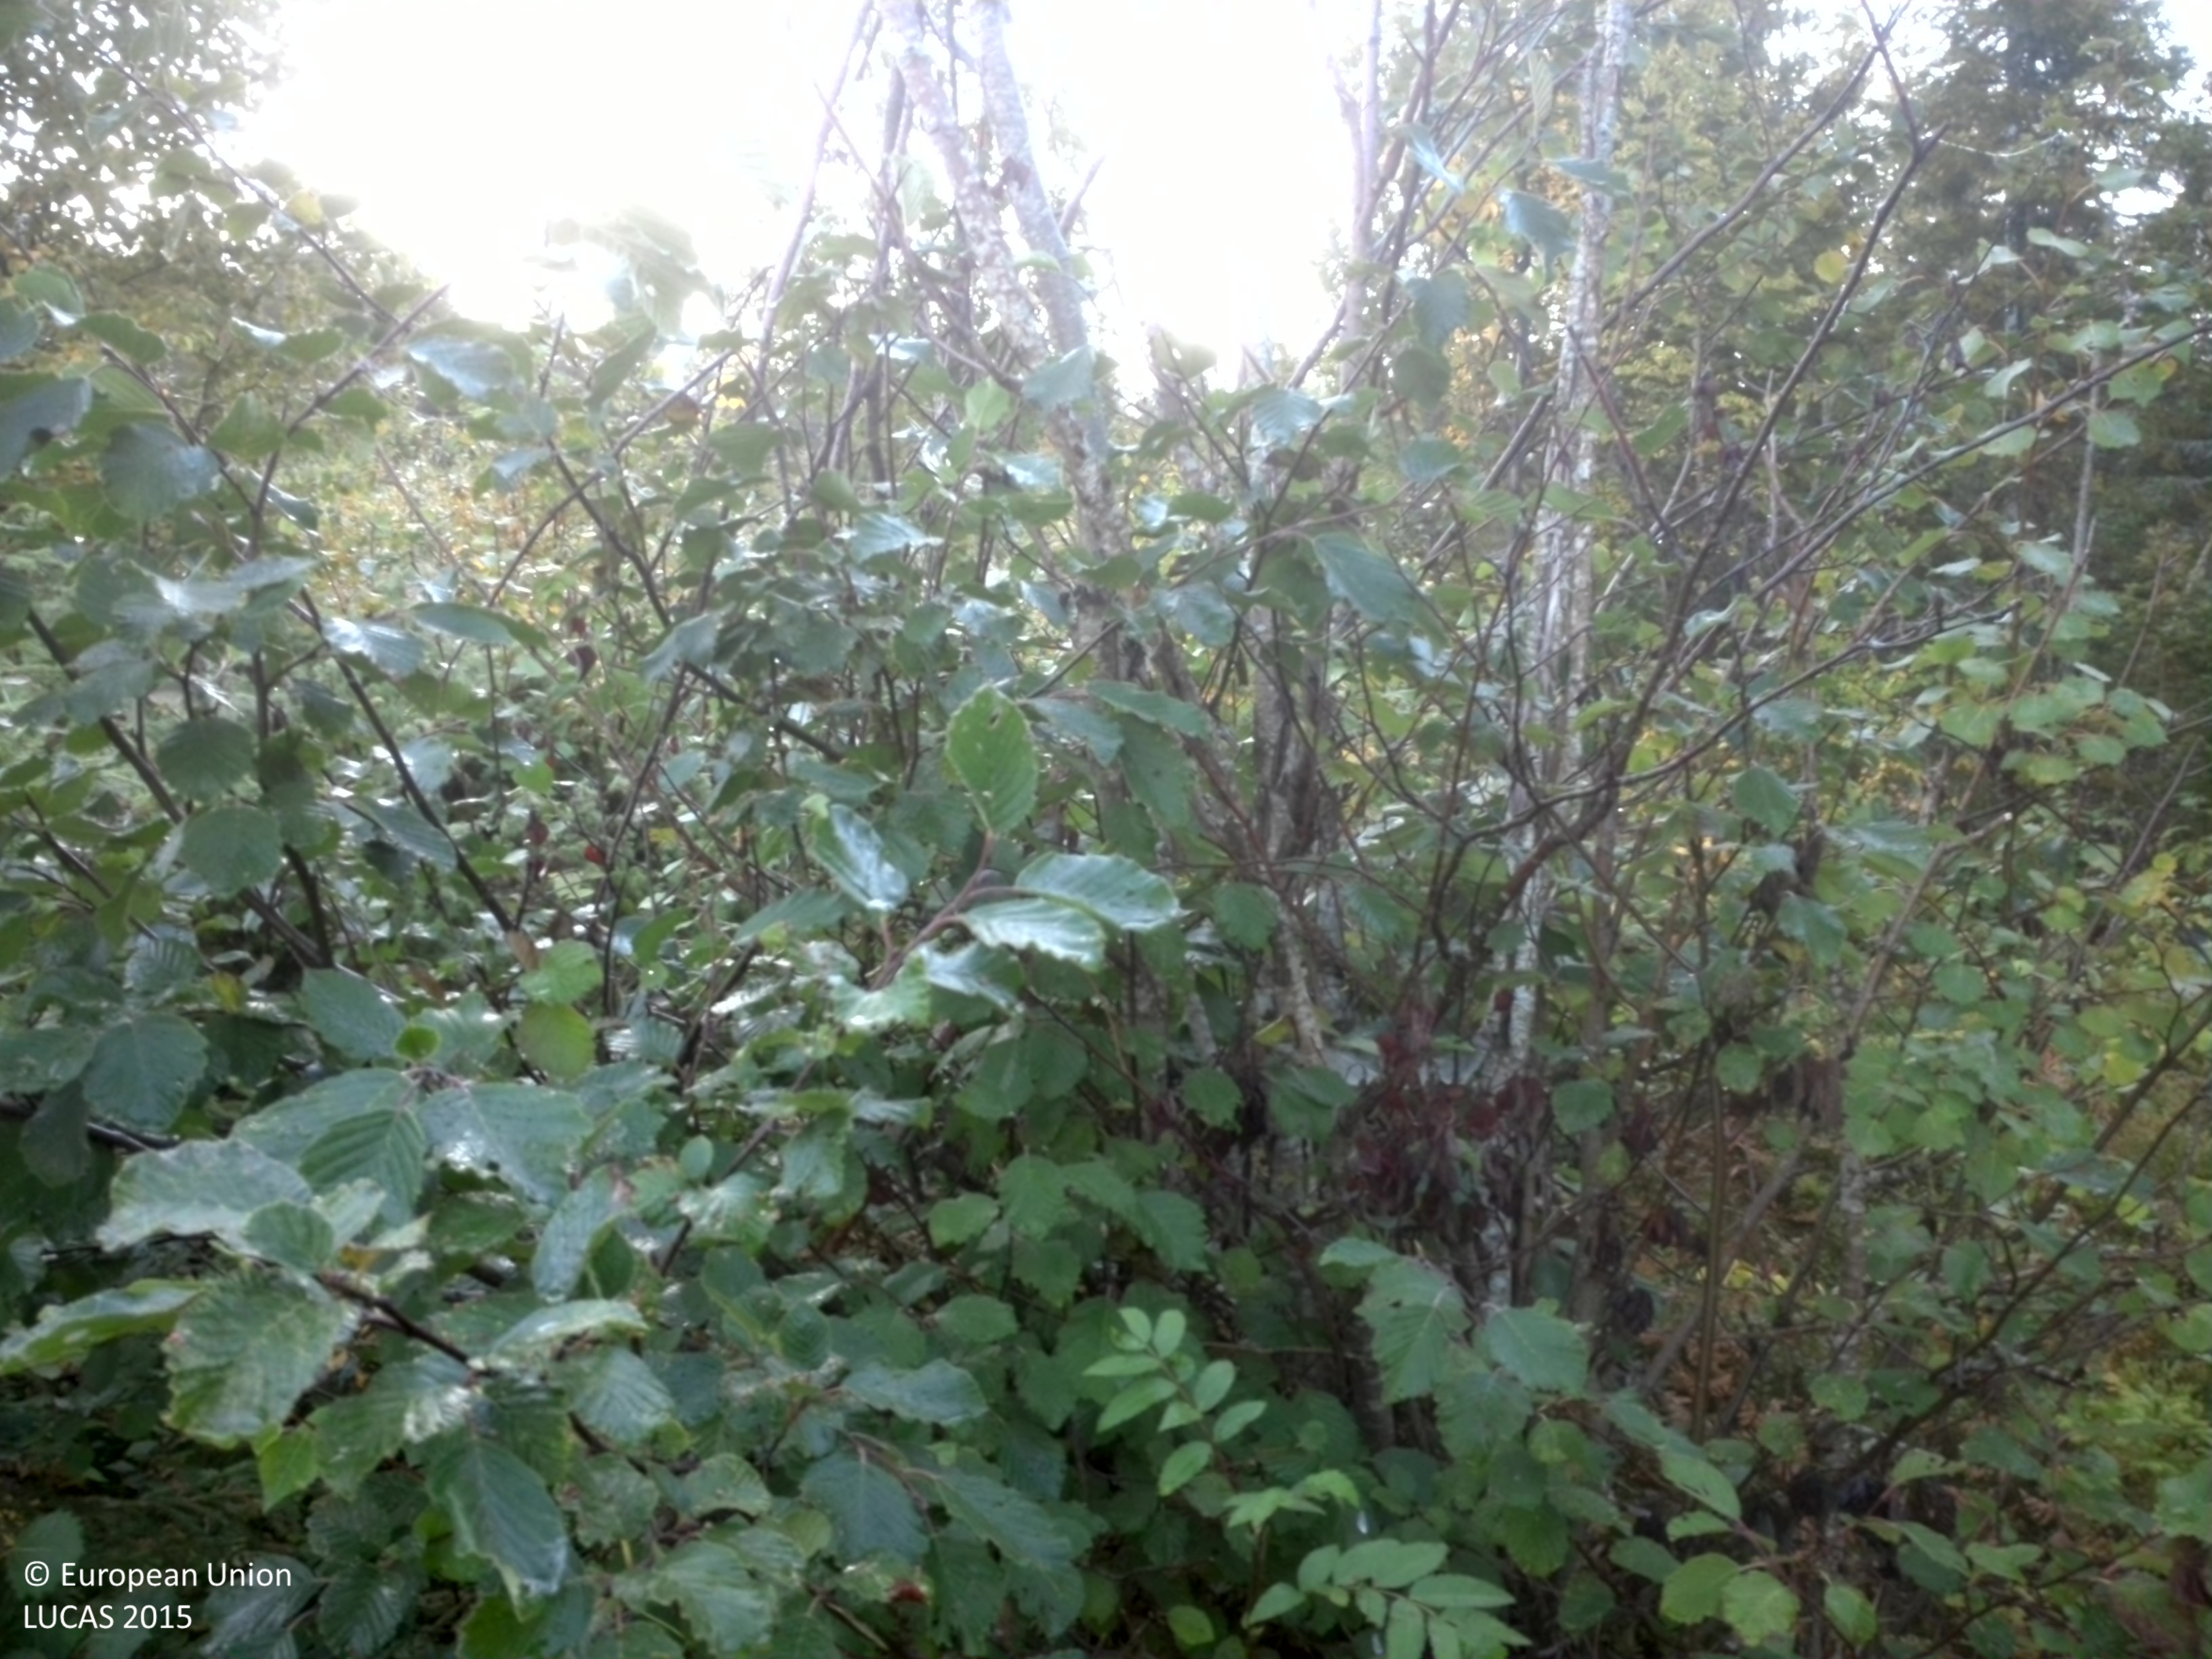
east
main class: Woodland
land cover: Broadleaved woodland
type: boreal forest
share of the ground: 50 - 75 %
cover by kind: broadleaved forest trees 55 %, coniferous forest trees 15 %, shrubs 15 %, herbaceous plants 15 %
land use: Forestry
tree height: < 5 m
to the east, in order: Broadleaved woodland; Spruce dominated mixed woodland; Pine dominated coniferous woodland; Spruce dominated coniferous woodland; Ditches and canals; Spruce dominated mixed woodland
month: September
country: SE
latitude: 64.4229
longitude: 20.0854
